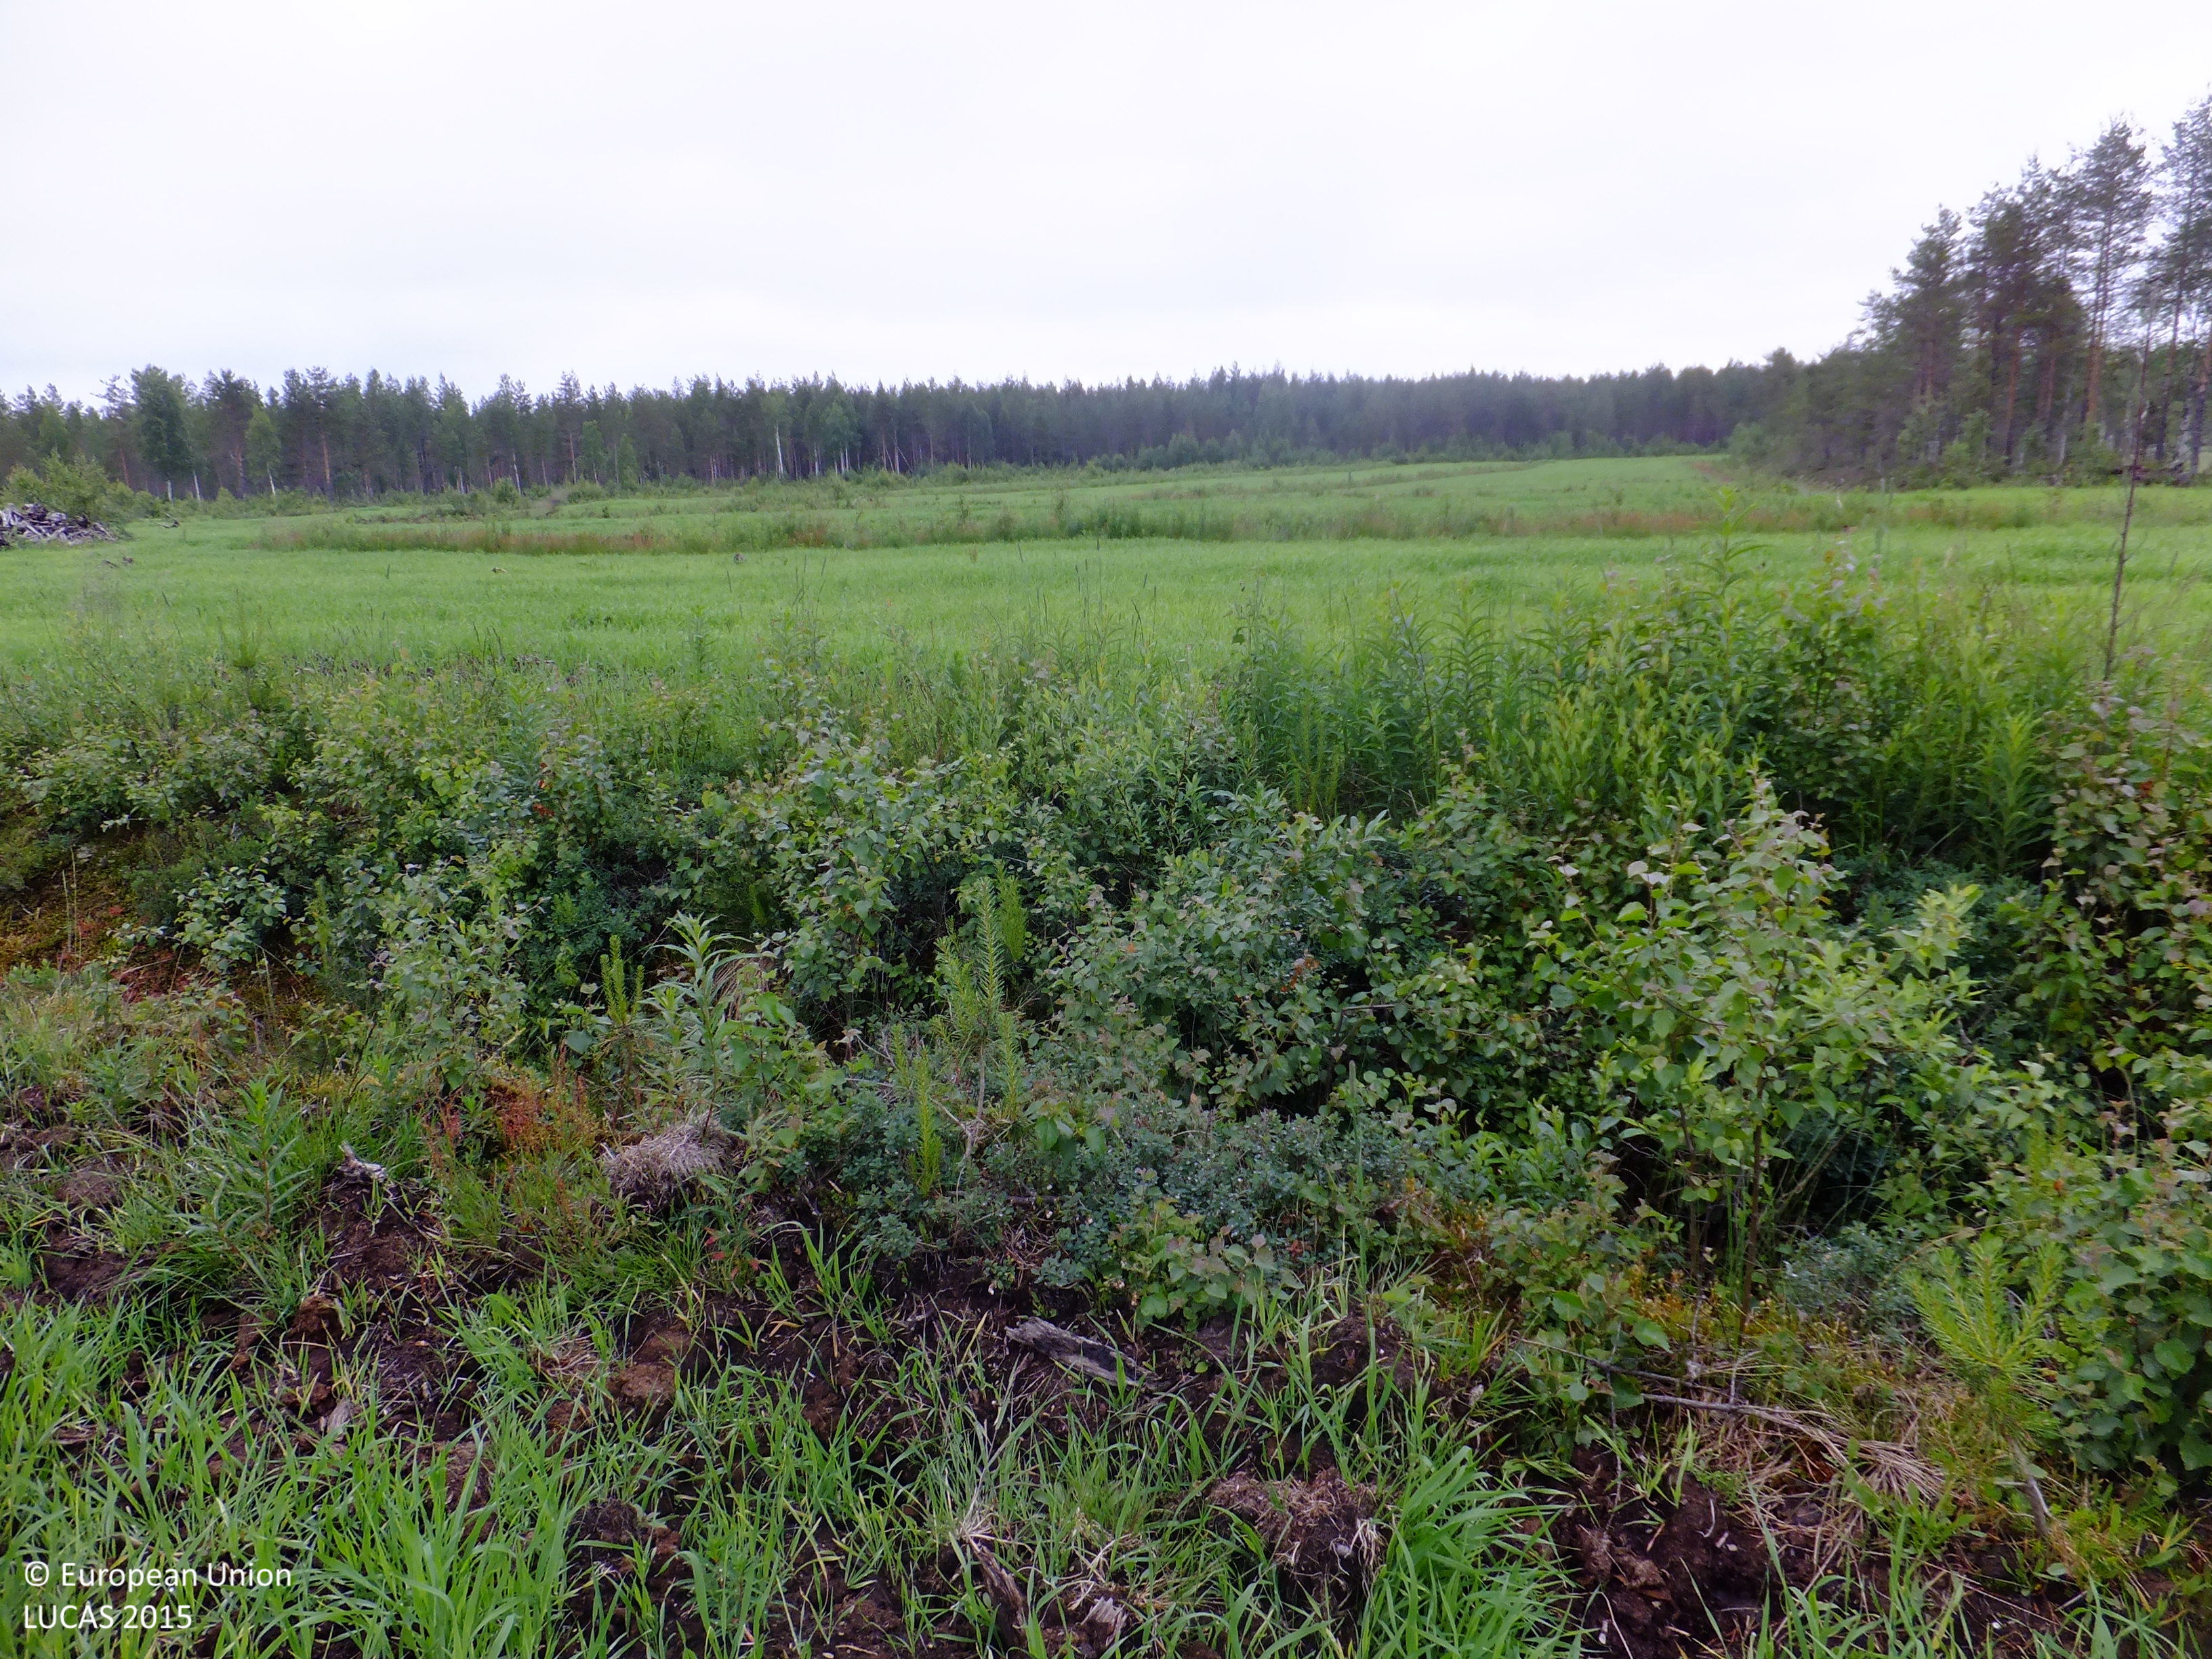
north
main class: Cropland
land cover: Barley
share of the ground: 50 - 75 %
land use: Agriculture (excluding fallow land and kitchen gardens)
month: July
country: FI
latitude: 63.1577
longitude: 24.6773
